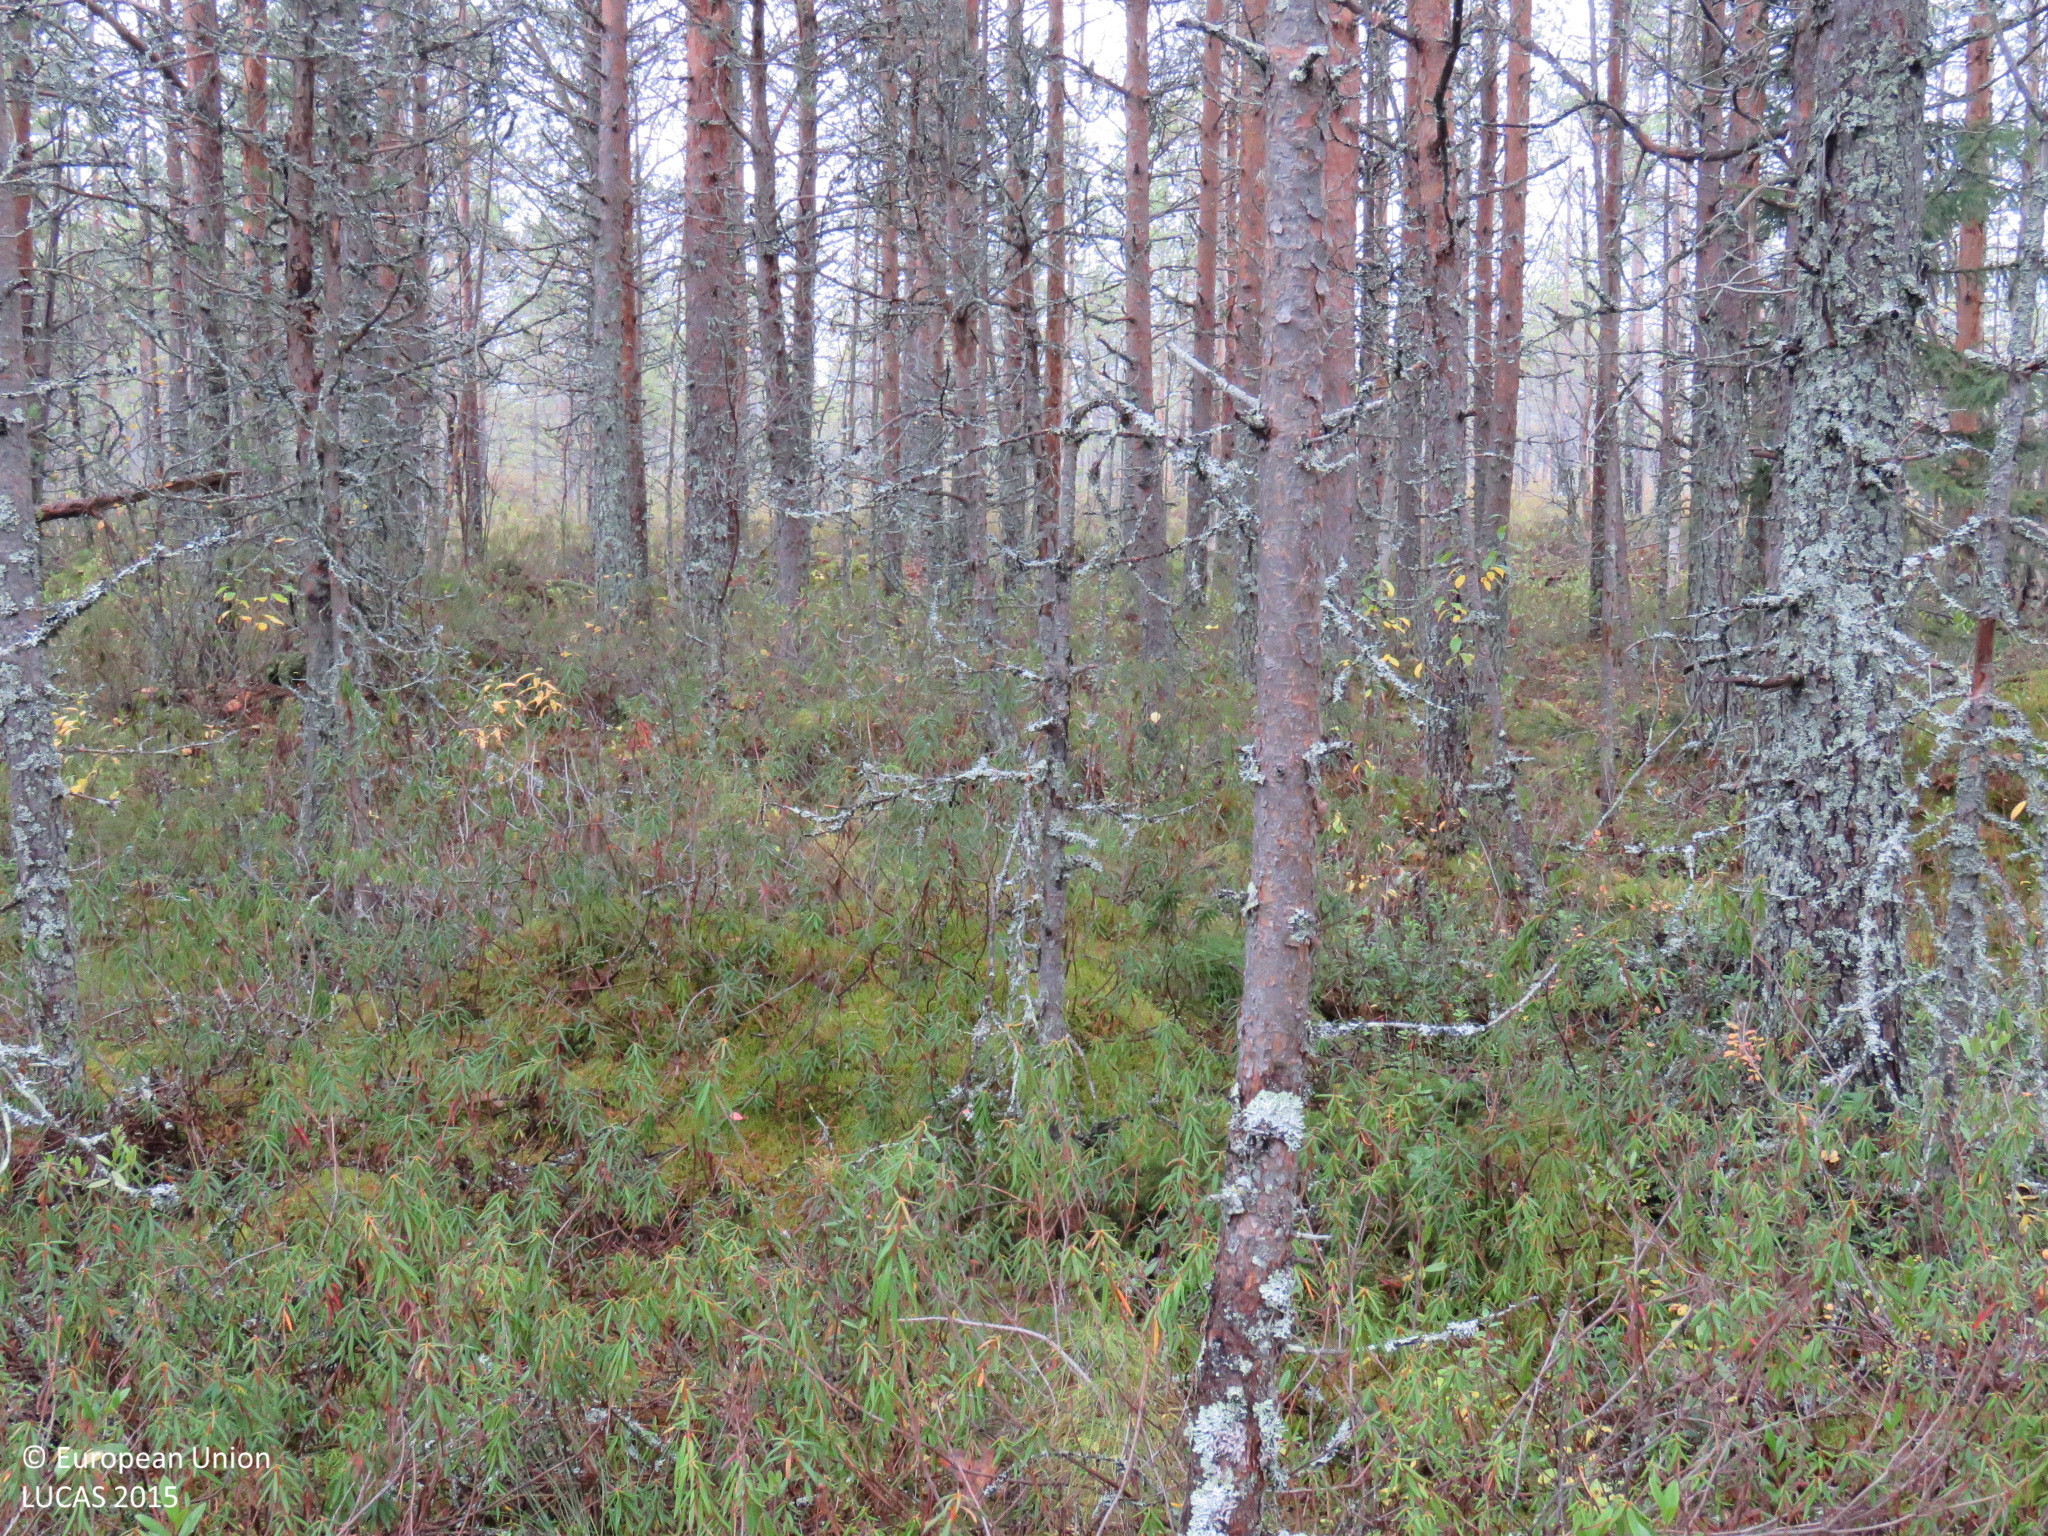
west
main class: Woodland
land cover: Pine dominated coniferous woodland
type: mire and swamp forests
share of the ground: > 75 %
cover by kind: coniferous forest trees 70 %, shrubs 15 %, lichens and mosses 10 %, broadleaved forest trees 5 %
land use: Forestry
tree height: > 5 m
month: September
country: FI
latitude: 65.2358
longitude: 27.1756
